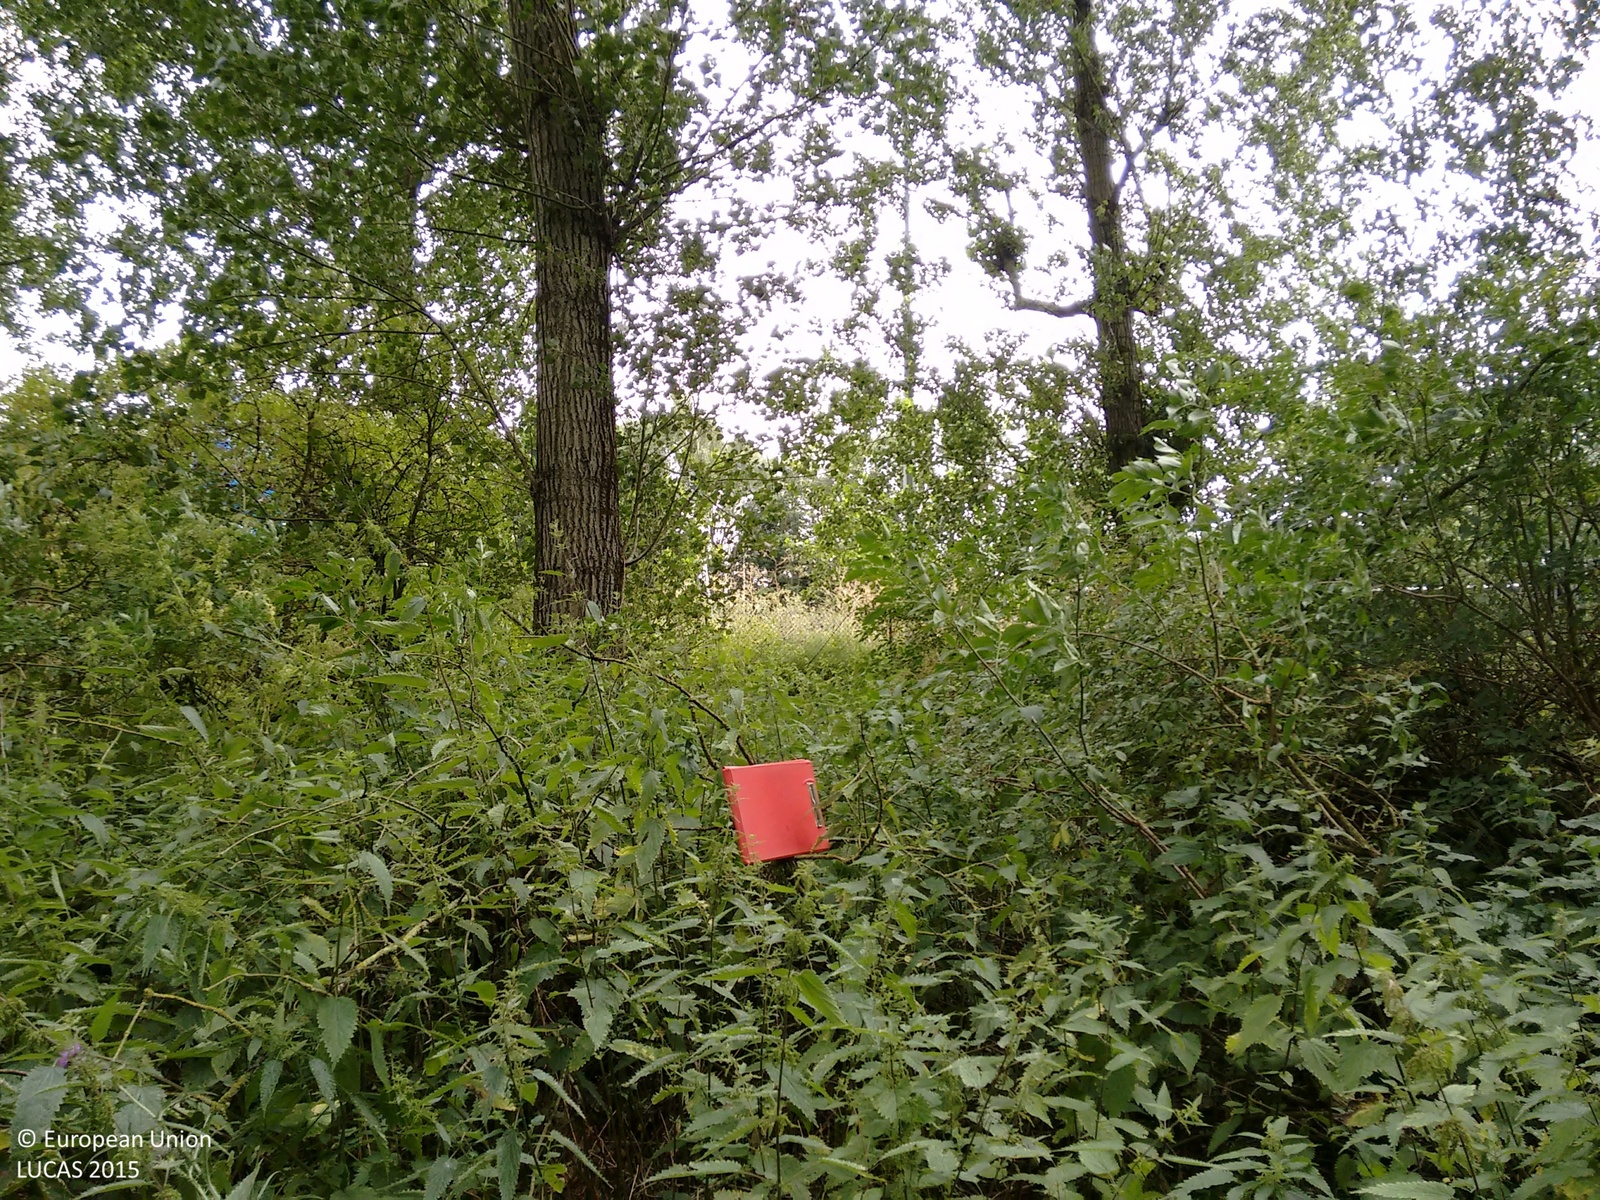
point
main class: Woodland
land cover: Broadleaved woodland
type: mesophytic deciduous forest
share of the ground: > 75 %
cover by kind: broadleaved forest trees 90 %, shrubs 5 %, herbaceous plants 5 %
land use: Semi-natural and natural areas not in use
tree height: > 5 m
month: July
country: GB
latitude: 51.6899
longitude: 0.0879
